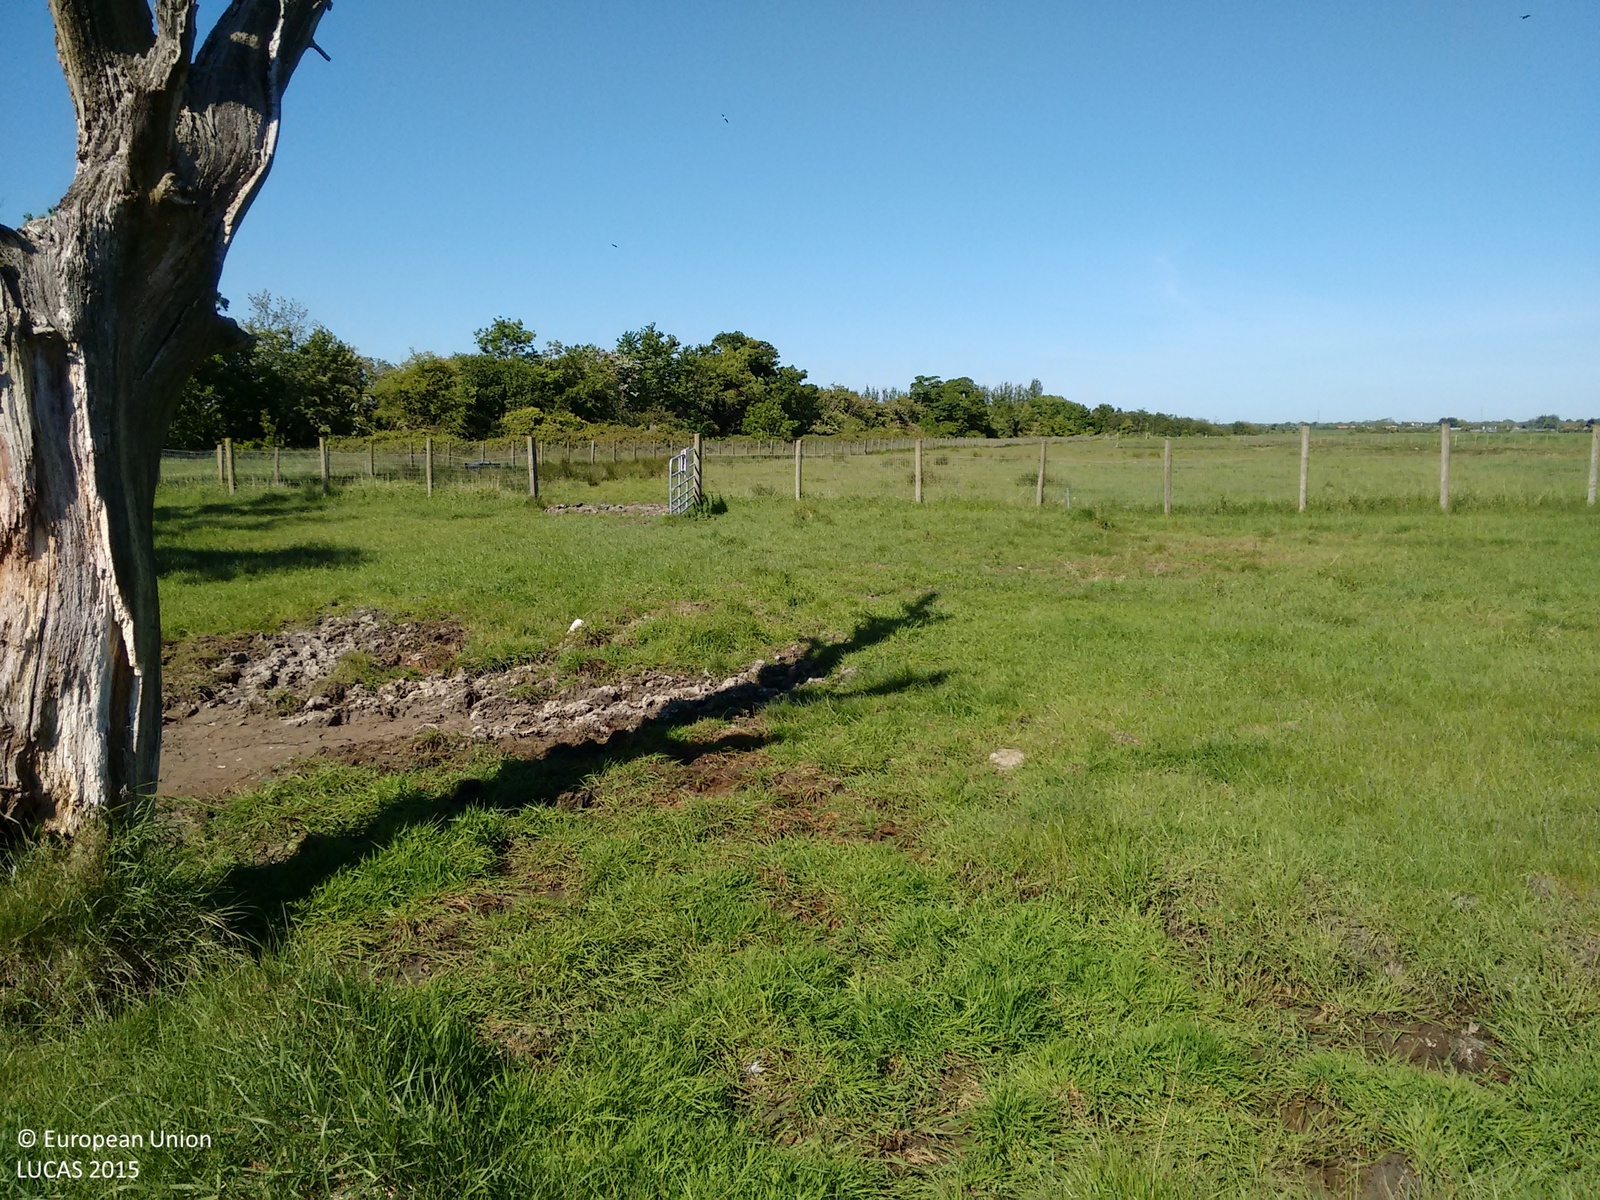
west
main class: Grassland
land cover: Grassland with sparse tree/shrub cover
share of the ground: > 75 %
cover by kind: herbaceous plants 80 %, unconsolidated bare surface 10 %, broadleaved forest trees 5 %, shrubs 5 %
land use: Agriculture (excluding fallow land and kitchen gardens)
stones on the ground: < 10 %
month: June
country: IE
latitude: 53.4980
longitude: -6.1717
